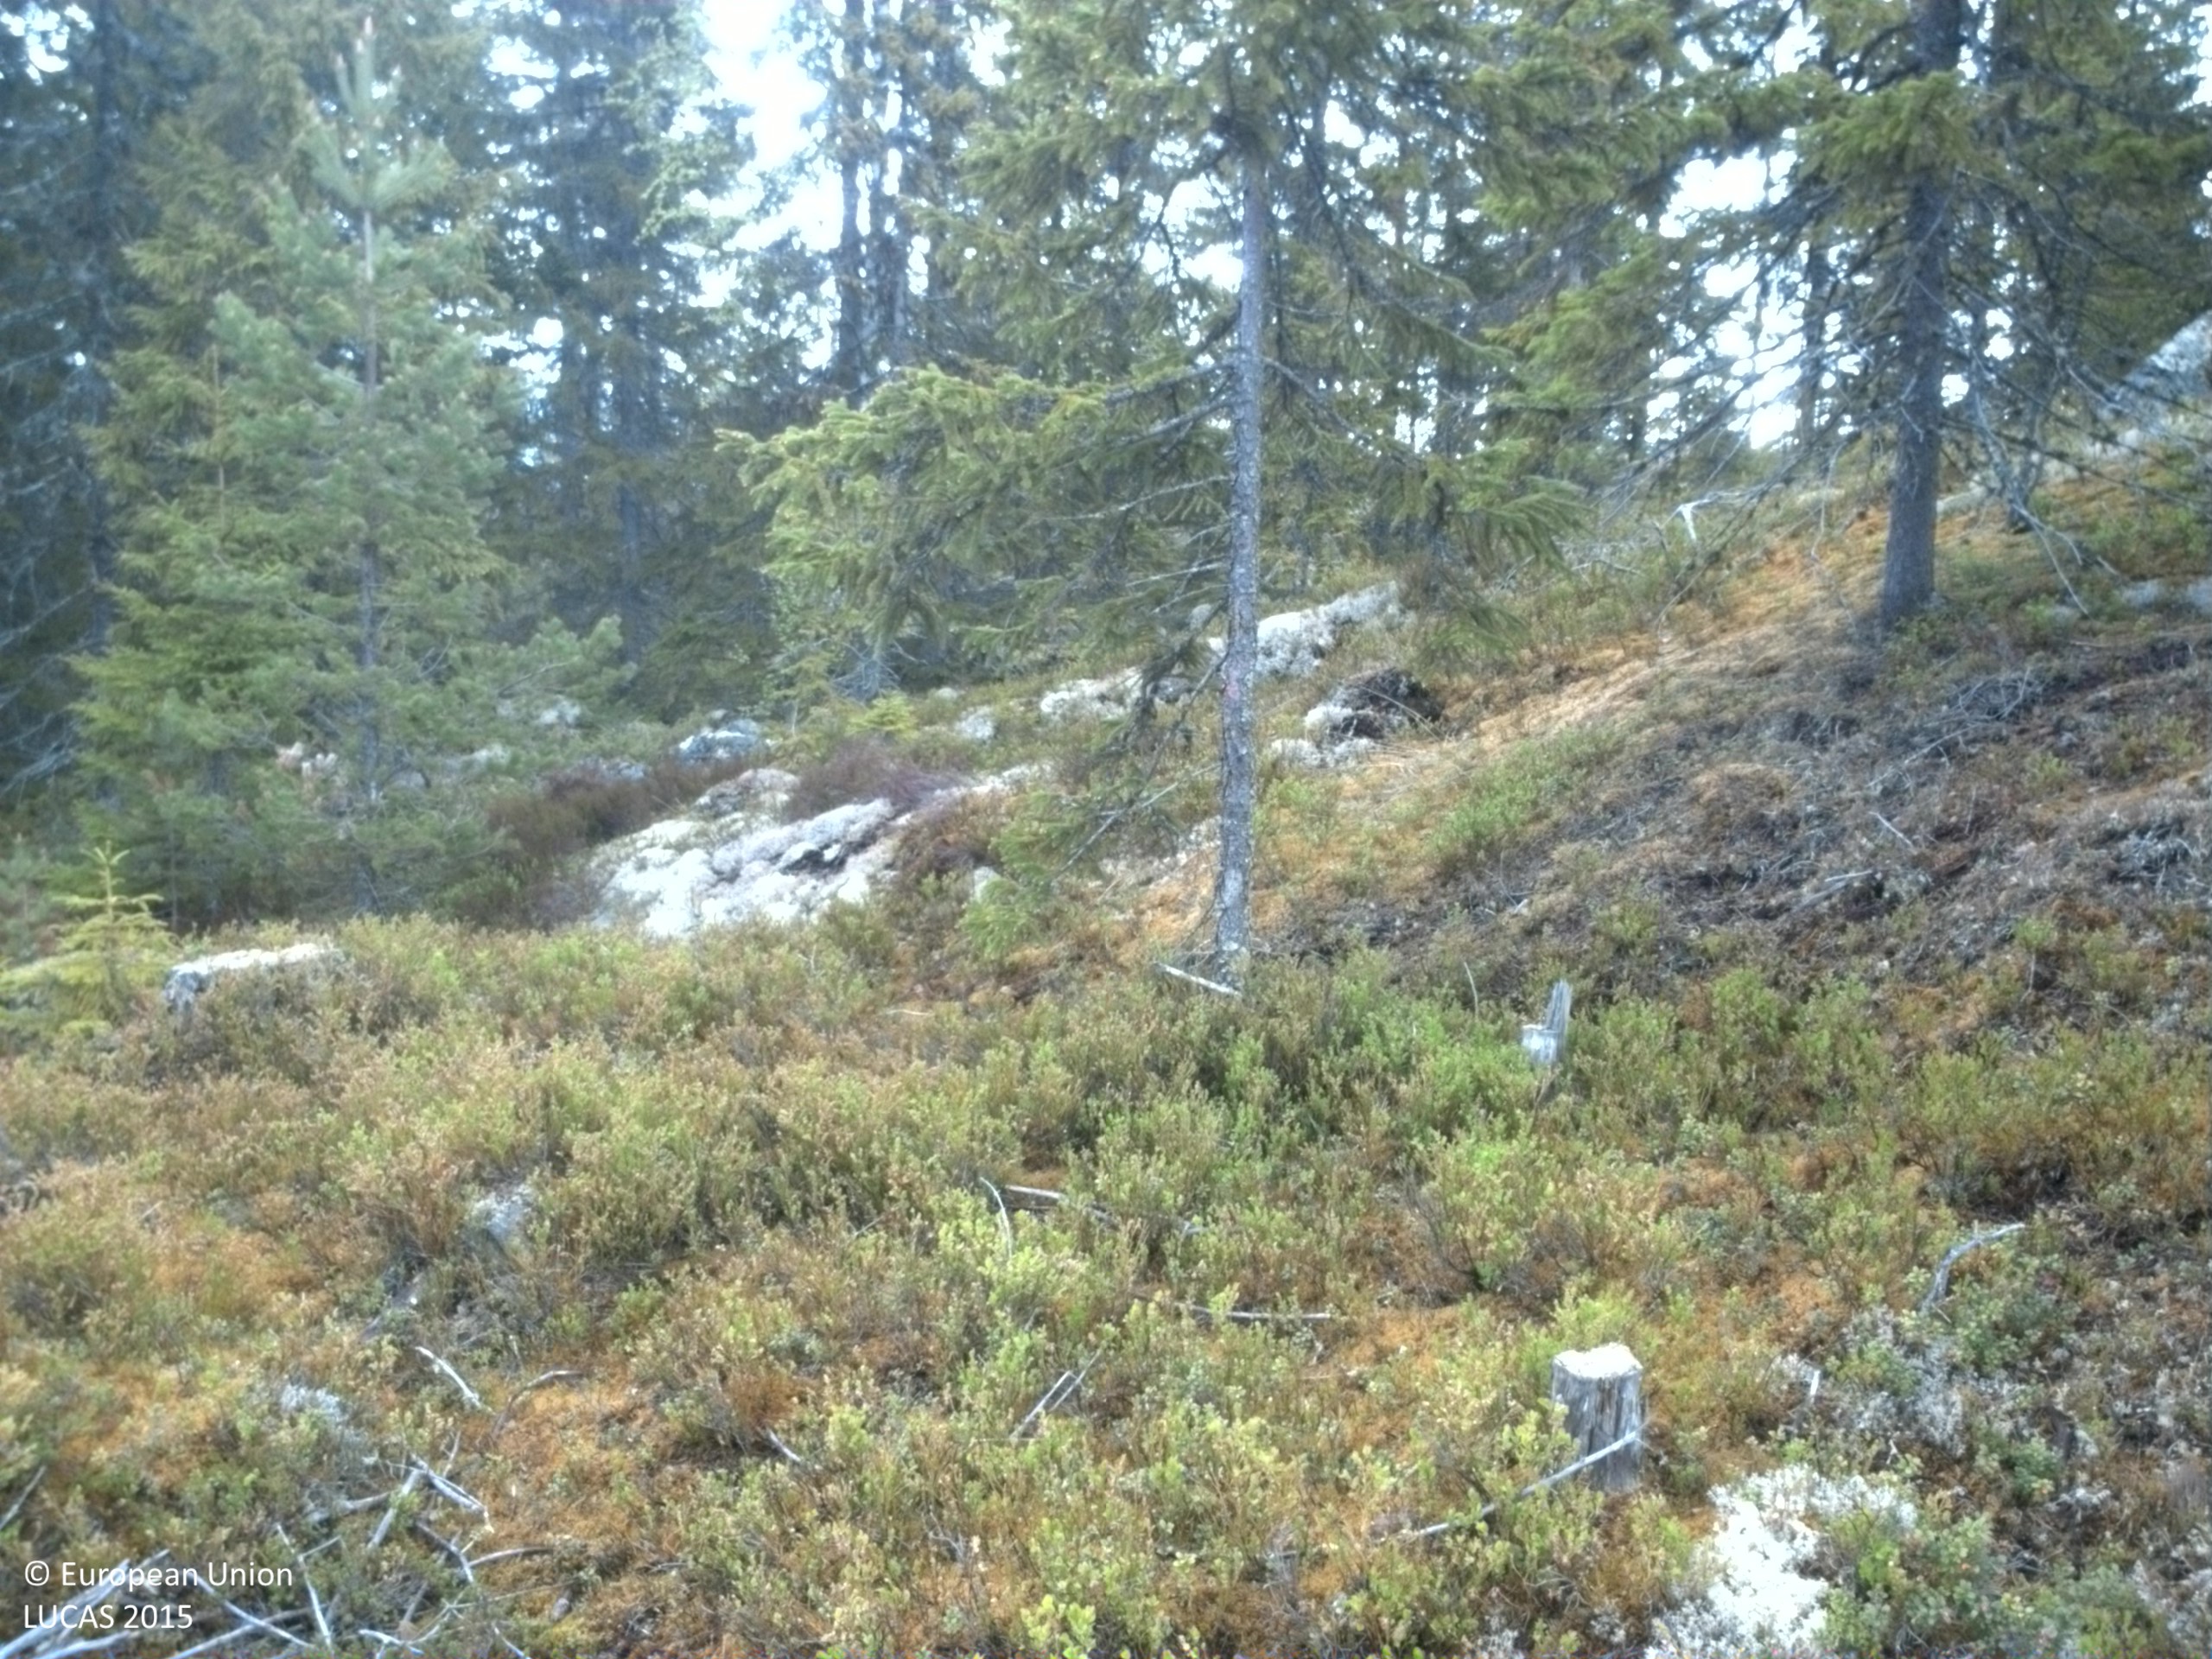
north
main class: Woodland
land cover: Pine dominated mixed woodland
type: boreal forest
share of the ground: 50 - 75 %
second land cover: Shrubland without tree cover
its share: 25 - 50 %
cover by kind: shrubs 40 %, coniferous forest trees 30 %, broadleaved forest trees 20 %, lichens and mosses 10 %
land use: Forestry
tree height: < 5 m
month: June
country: SE
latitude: 63.0871
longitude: 17.6801
